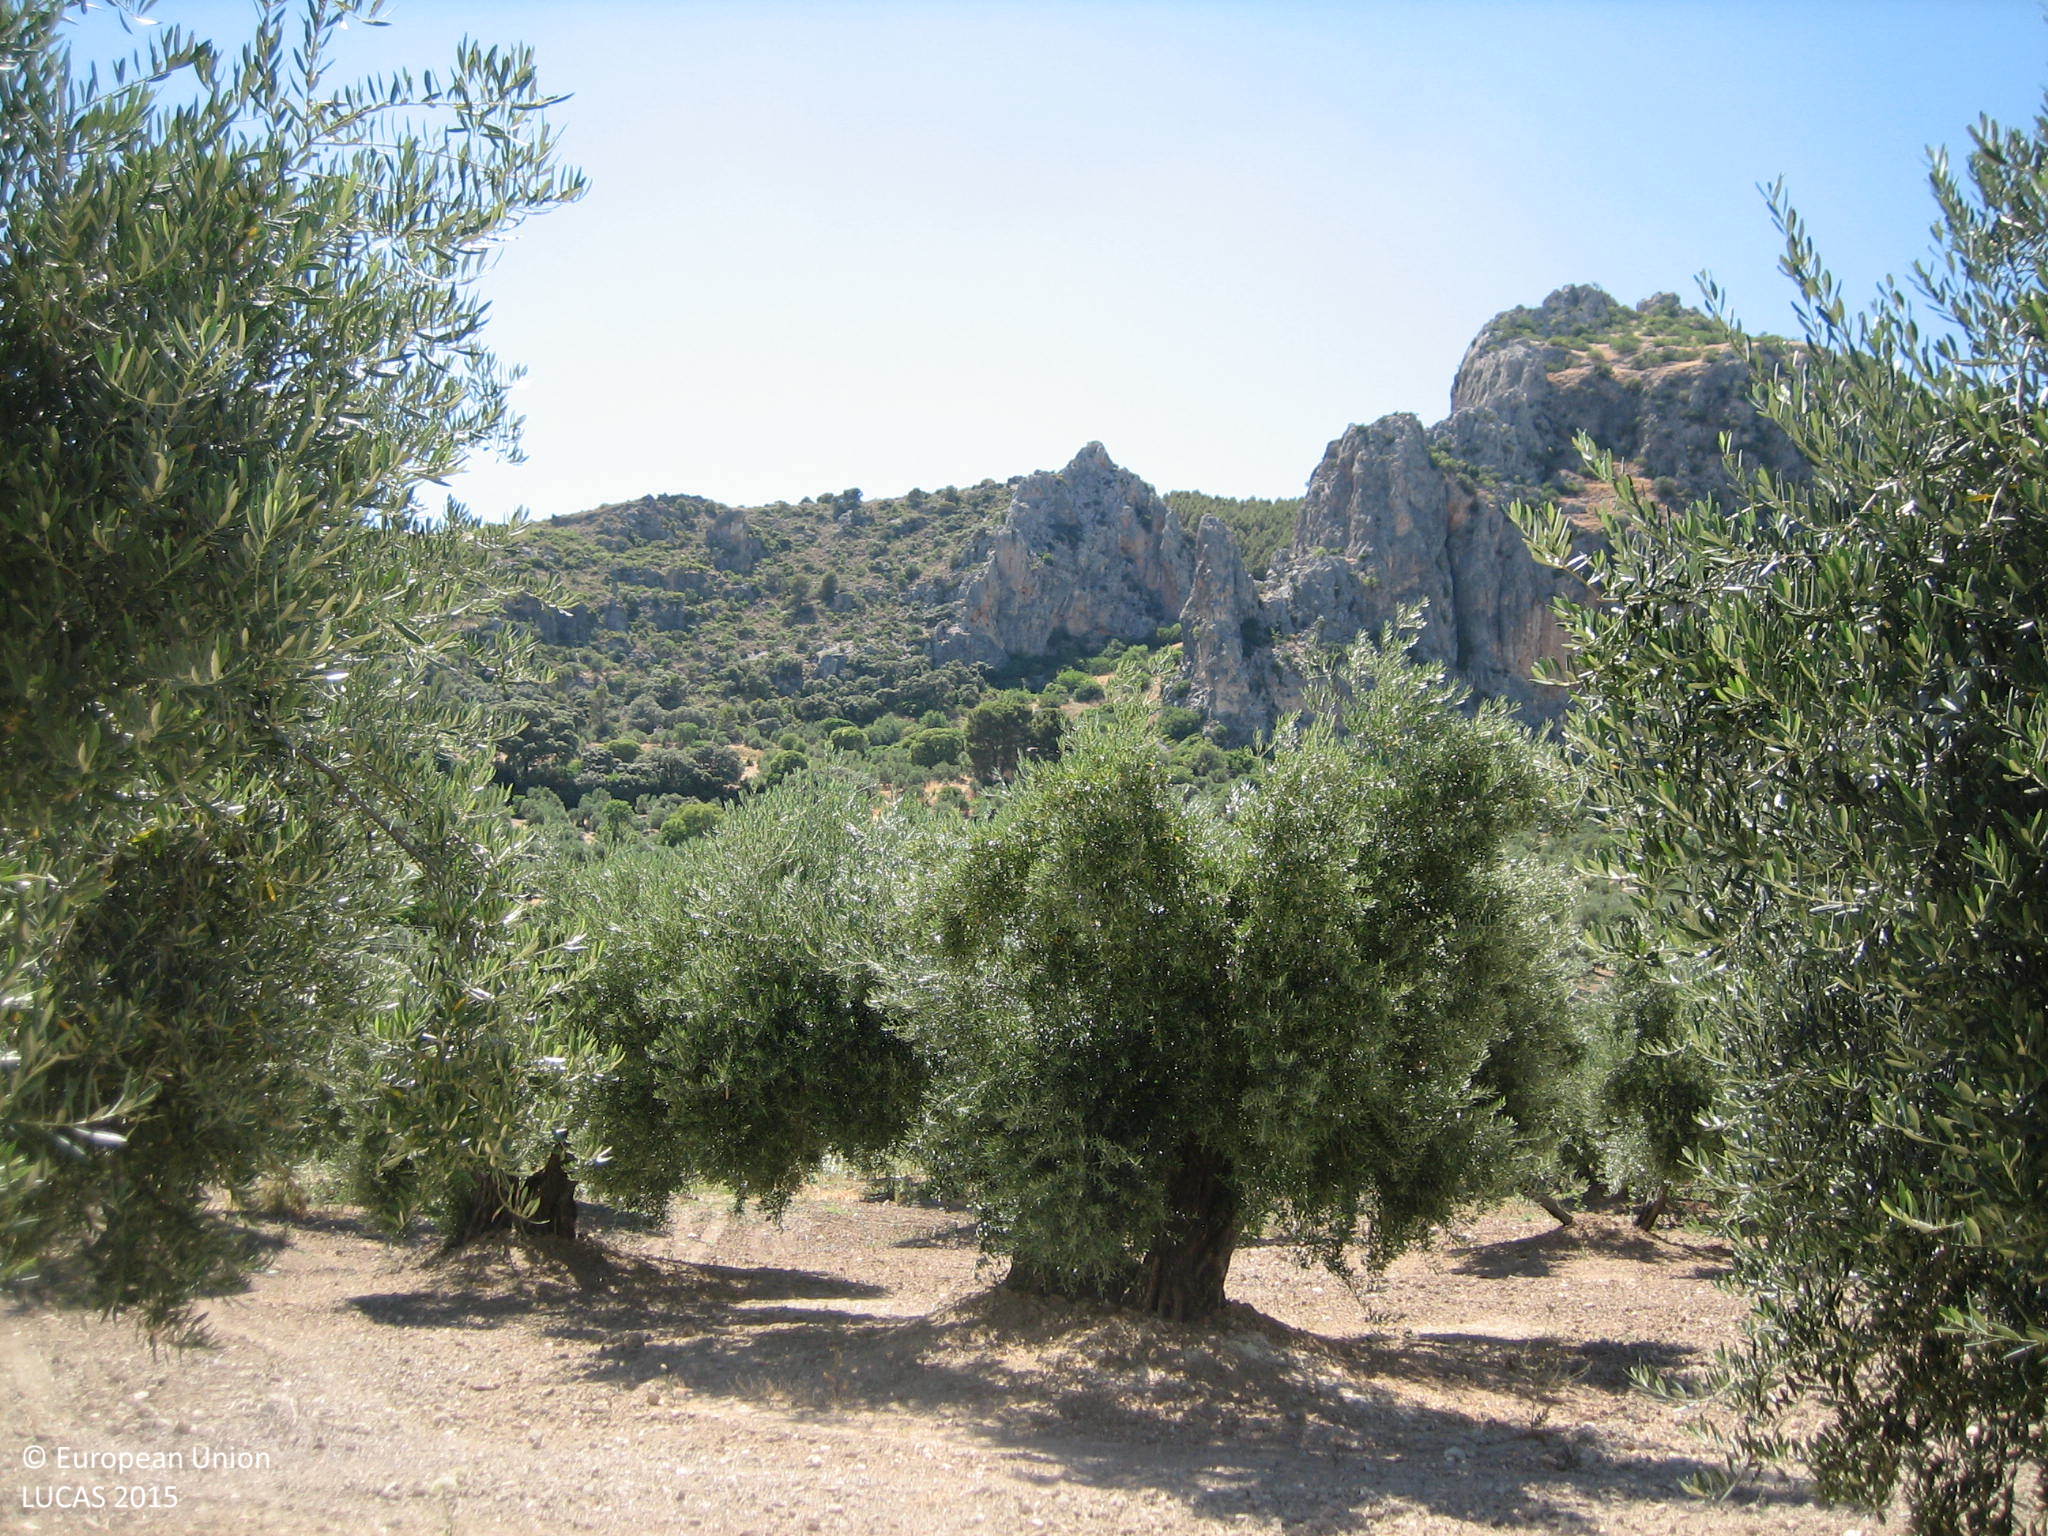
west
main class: Cropland
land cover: Olive groves
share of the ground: 25 - 50 %
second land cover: Other bare soil
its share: > 75 %
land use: Agriculture (excluding fallow land and kitchen gardens)
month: June
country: ES
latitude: 37.7299
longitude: -3.7858
